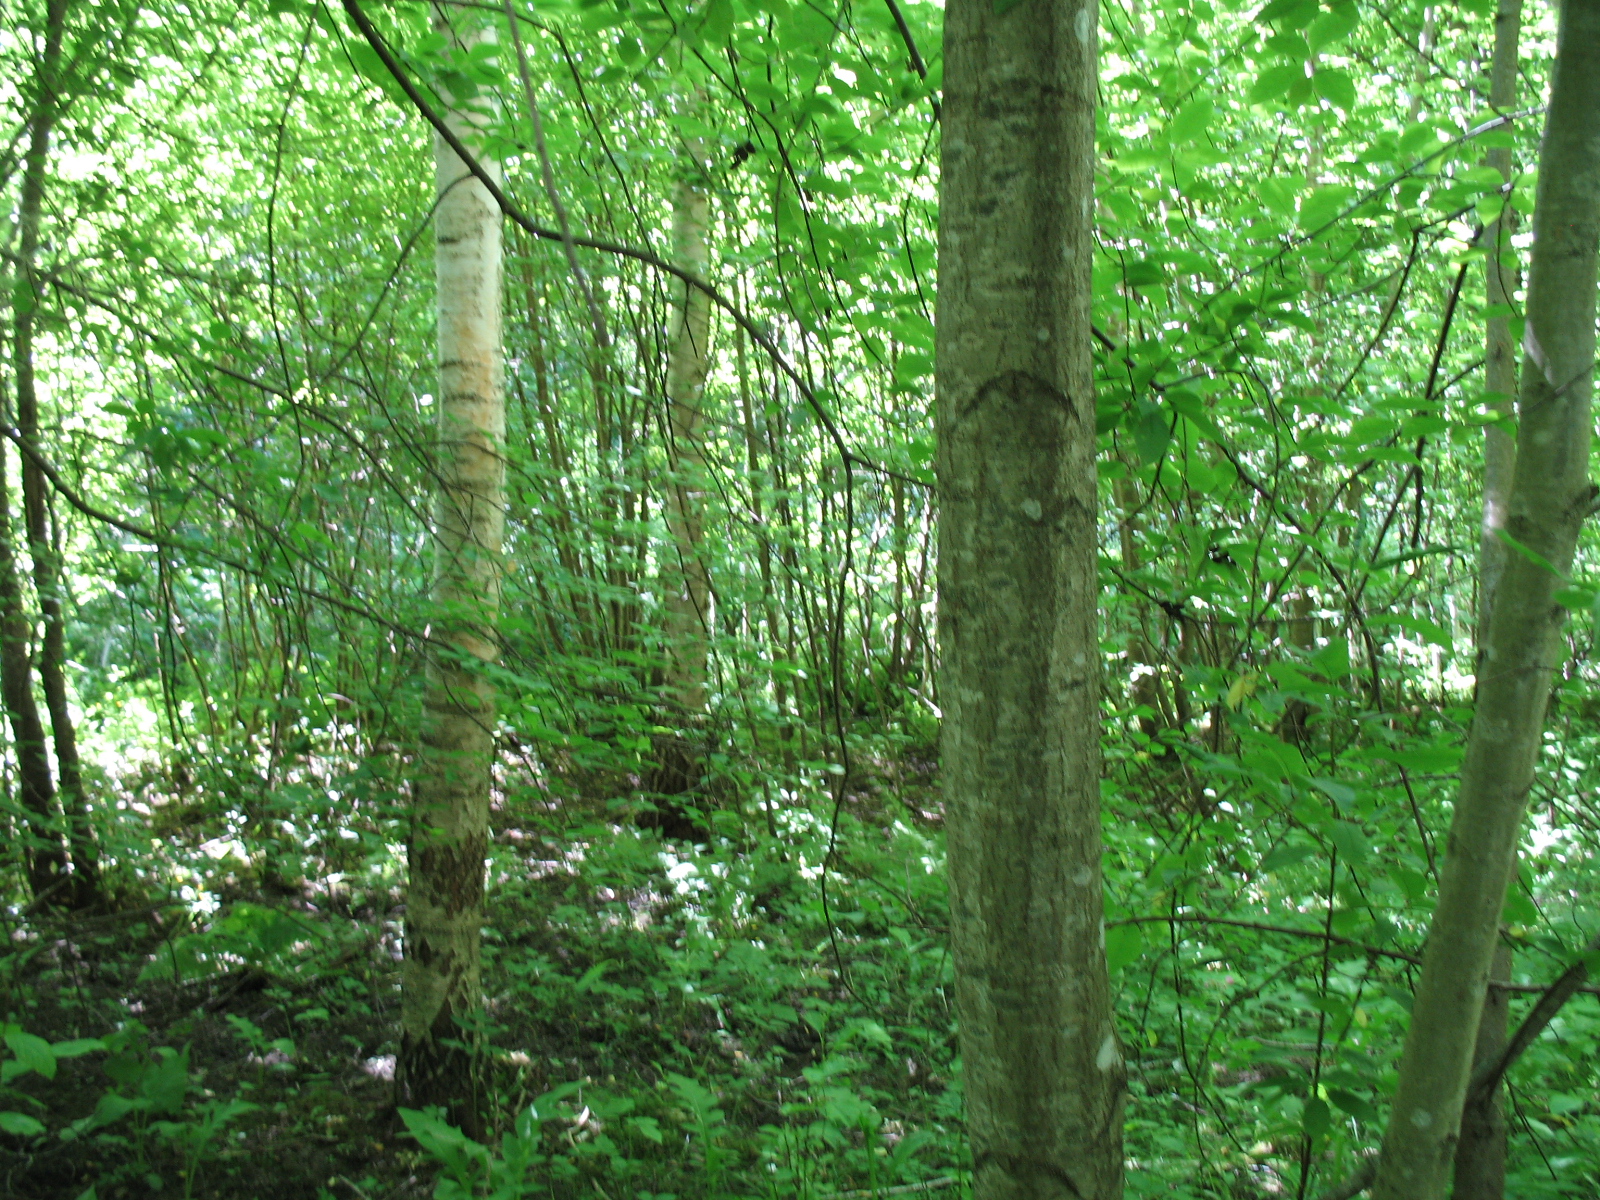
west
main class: Woodland
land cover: Broadleaved woodland
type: non-riverine alder, birch or aspen forest
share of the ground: > 75 %
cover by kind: broadleaved forest trees 100 %
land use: Forestry
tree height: > 5 m
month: June
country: LV
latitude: 56.5162
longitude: 23.4496
